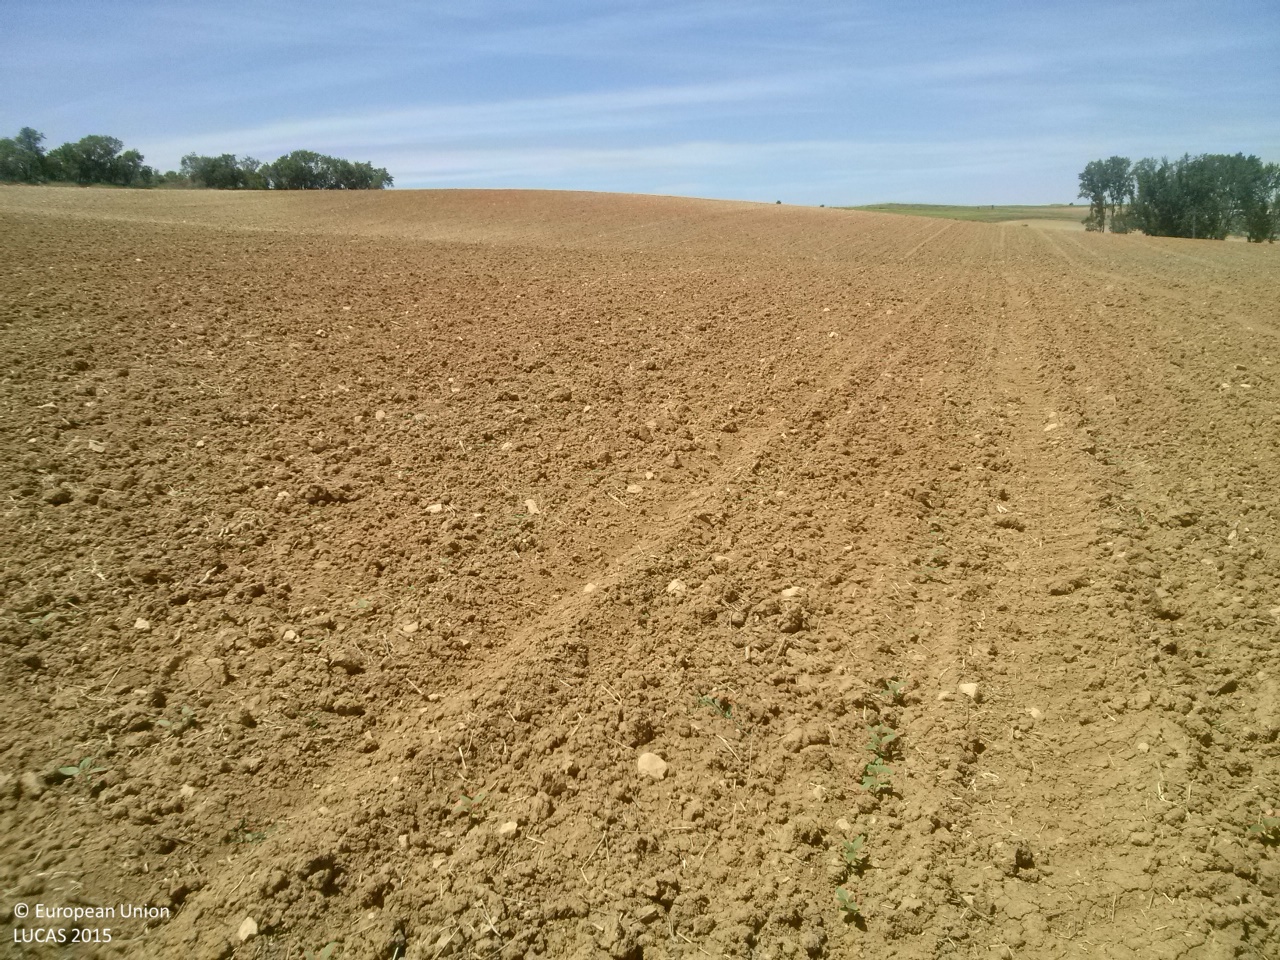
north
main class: Cropland
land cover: Sunflower
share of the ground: < 10 %
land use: Agriculture (excluding fallow land and kitchen gardens)
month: May
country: ES
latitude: 40.0223
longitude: -2.7104
